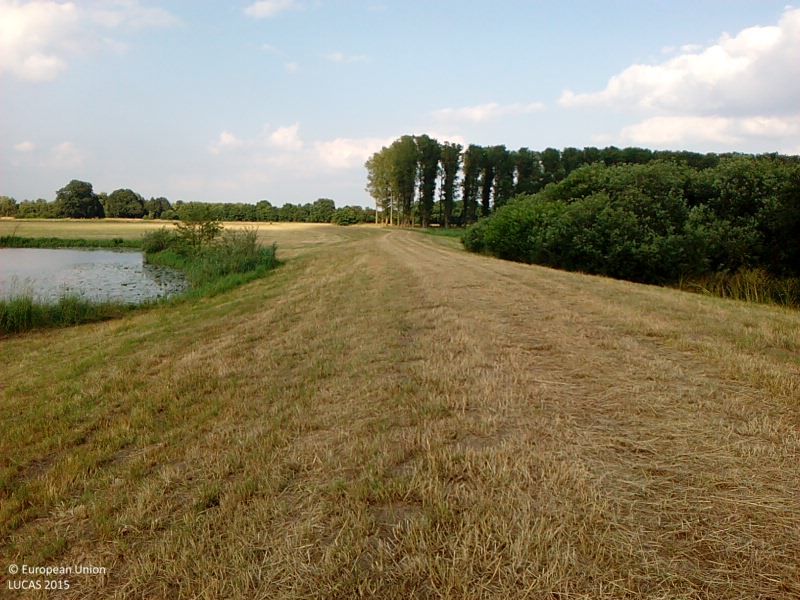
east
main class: Grassland
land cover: Grassland without tree/shrub cover
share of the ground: > 75 %
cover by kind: herbaceous plants 100 %
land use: Agriculture (excluding fallow land and kitchen gardens)
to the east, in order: Grassland without tree/shrub cover; Shrubland with sparse tree cover; Ditches and canals; Grass margins; Maize; Spontaneously vegetated surfaces; Spruce dominated mixed woodland; Grassland without tree/shrub cover; Broadleaved woodland
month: July
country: DE
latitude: 52.6730
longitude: 7.4123
